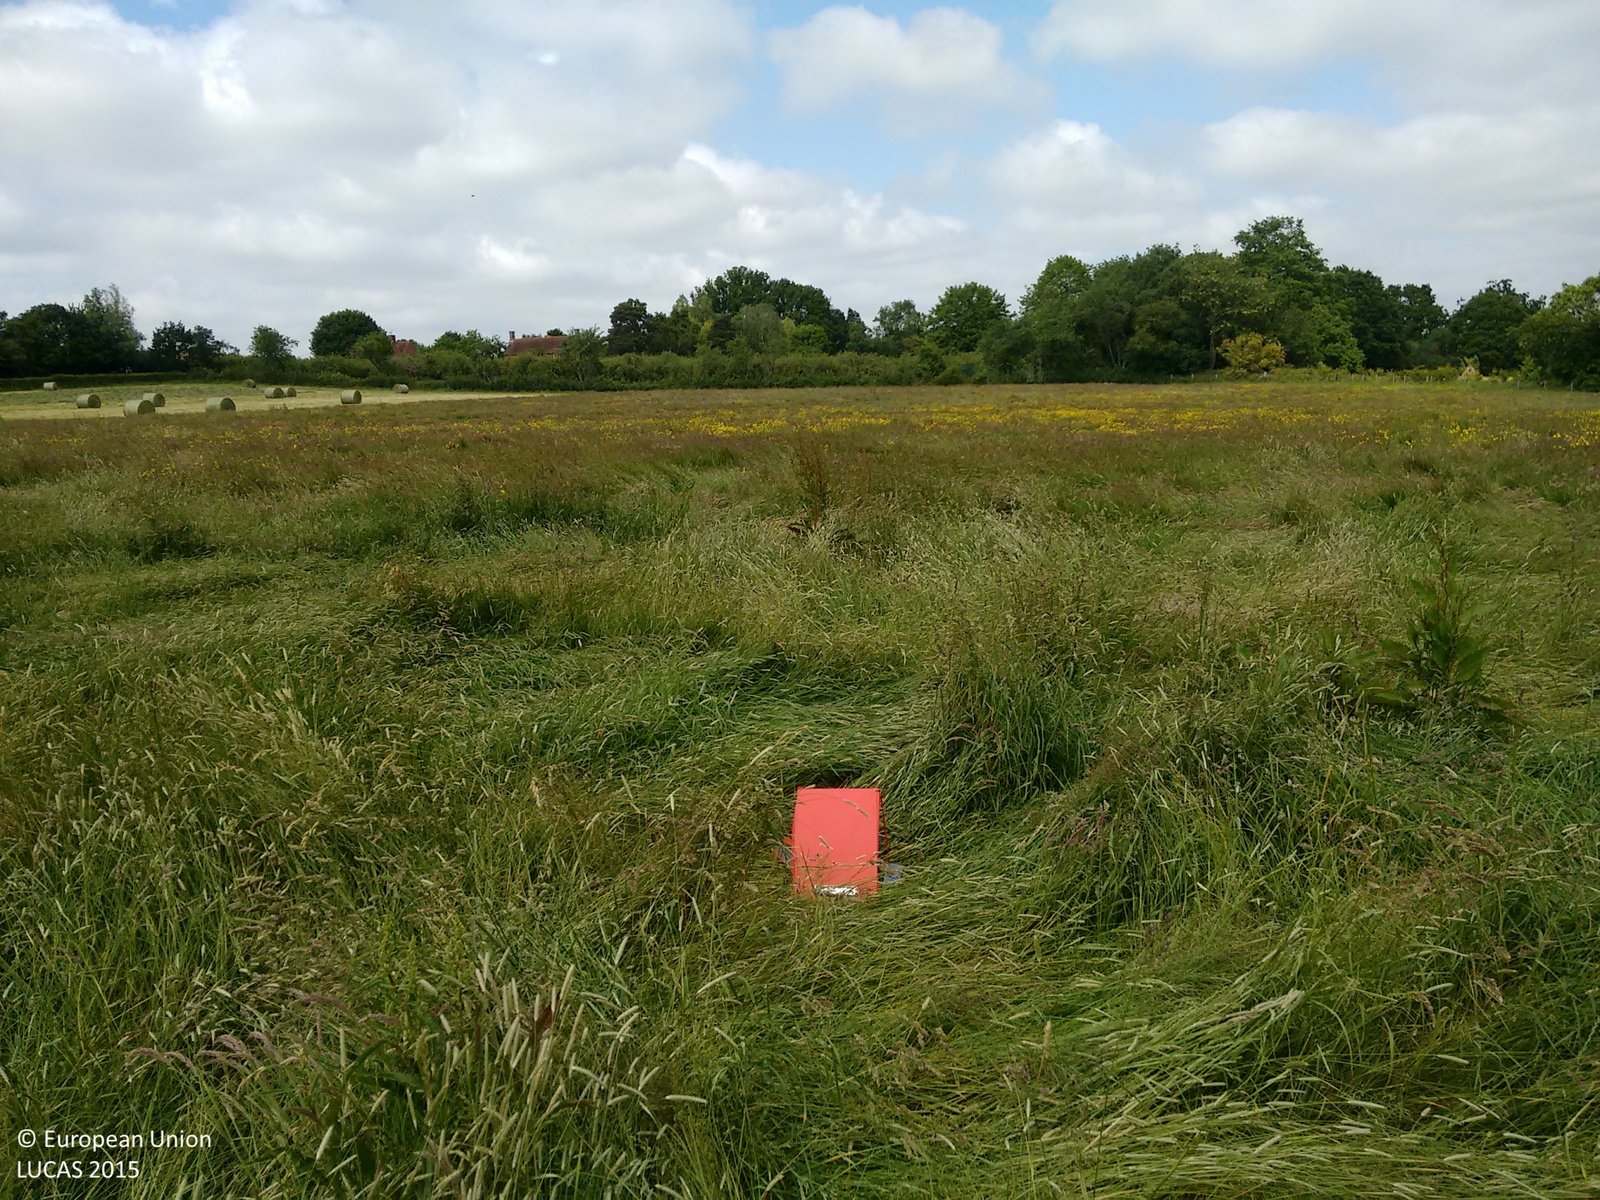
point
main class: Grassland
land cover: Grassland without tree/shrub cover
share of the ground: > 75 %
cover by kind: herbaceous plants 100 %
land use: Agriculture (excluding fallow land and kitchen gardens)
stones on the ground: < 10 %
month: June
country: GB
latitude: 51.1335
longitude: 0.5838
